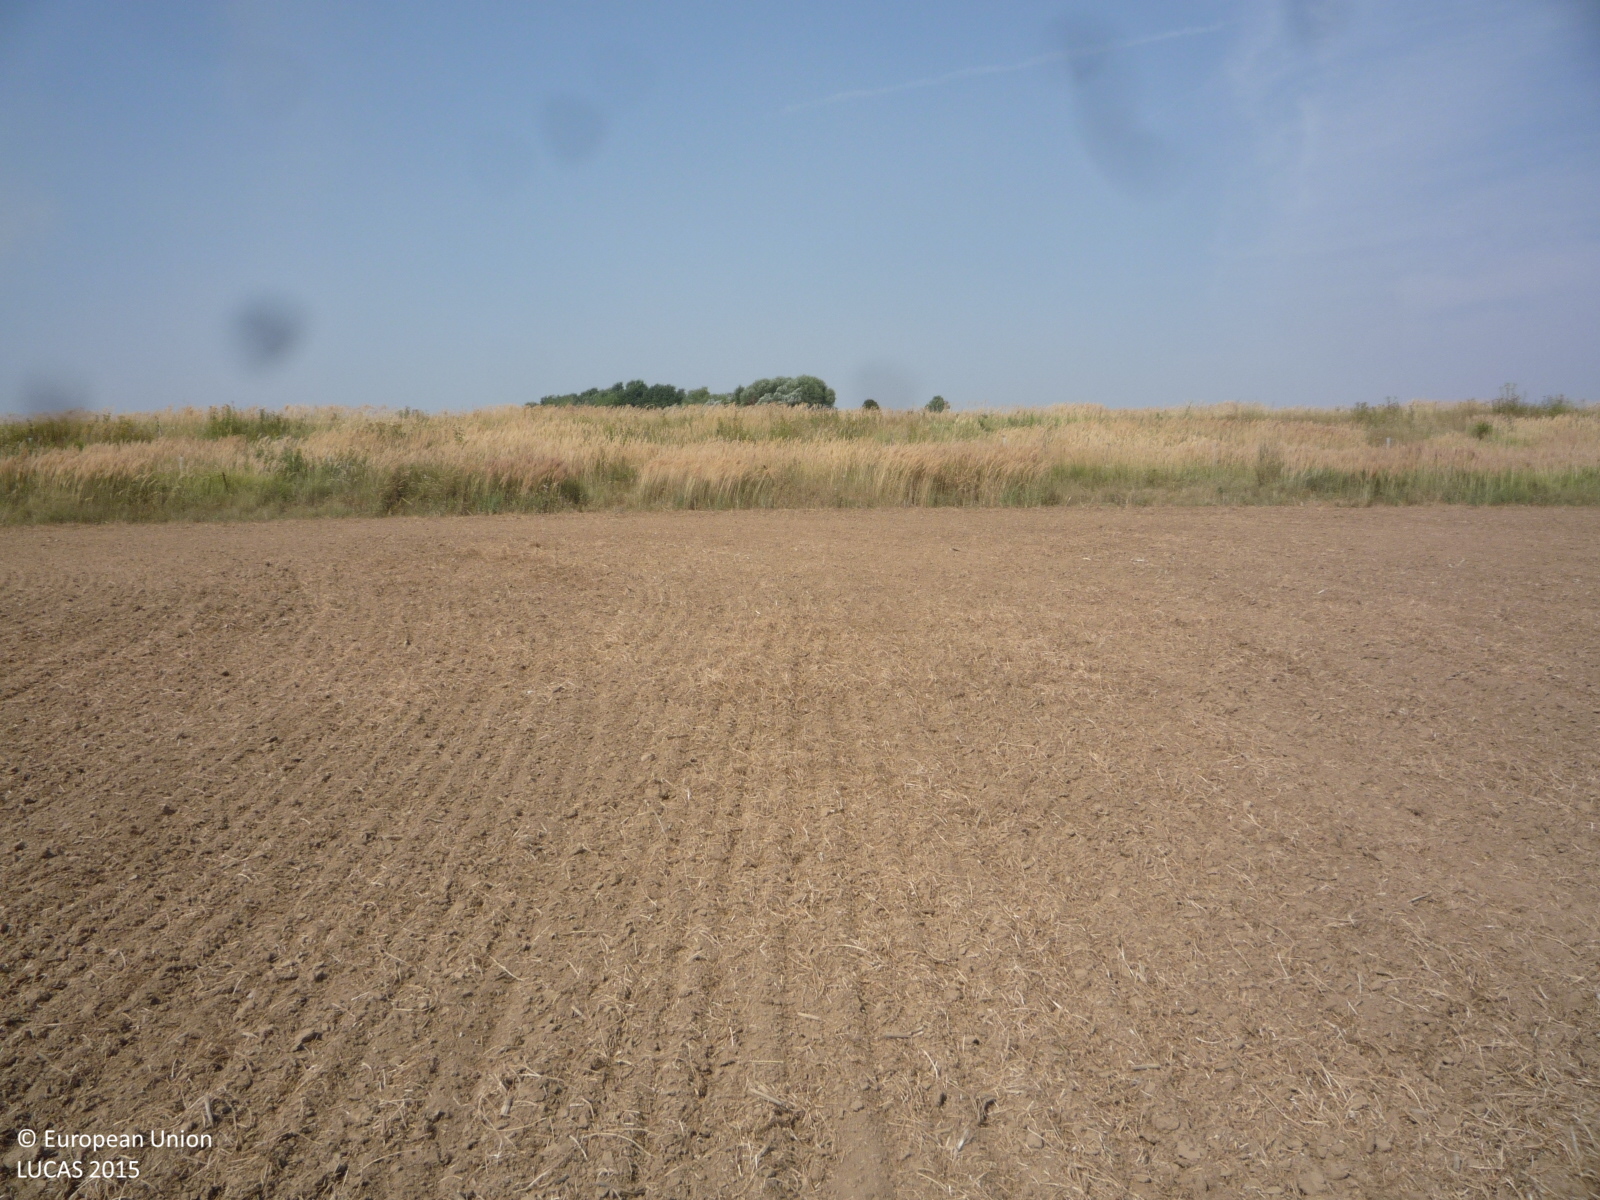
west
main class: Cropland
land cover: Dry pulses
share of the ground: < 10 %
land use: Agriculture (excluding fallow land and kitchen gardens)
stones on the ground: < 10 %
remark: Harvested field
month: August
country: CZ
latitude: 49.9512
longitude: 14.5033
